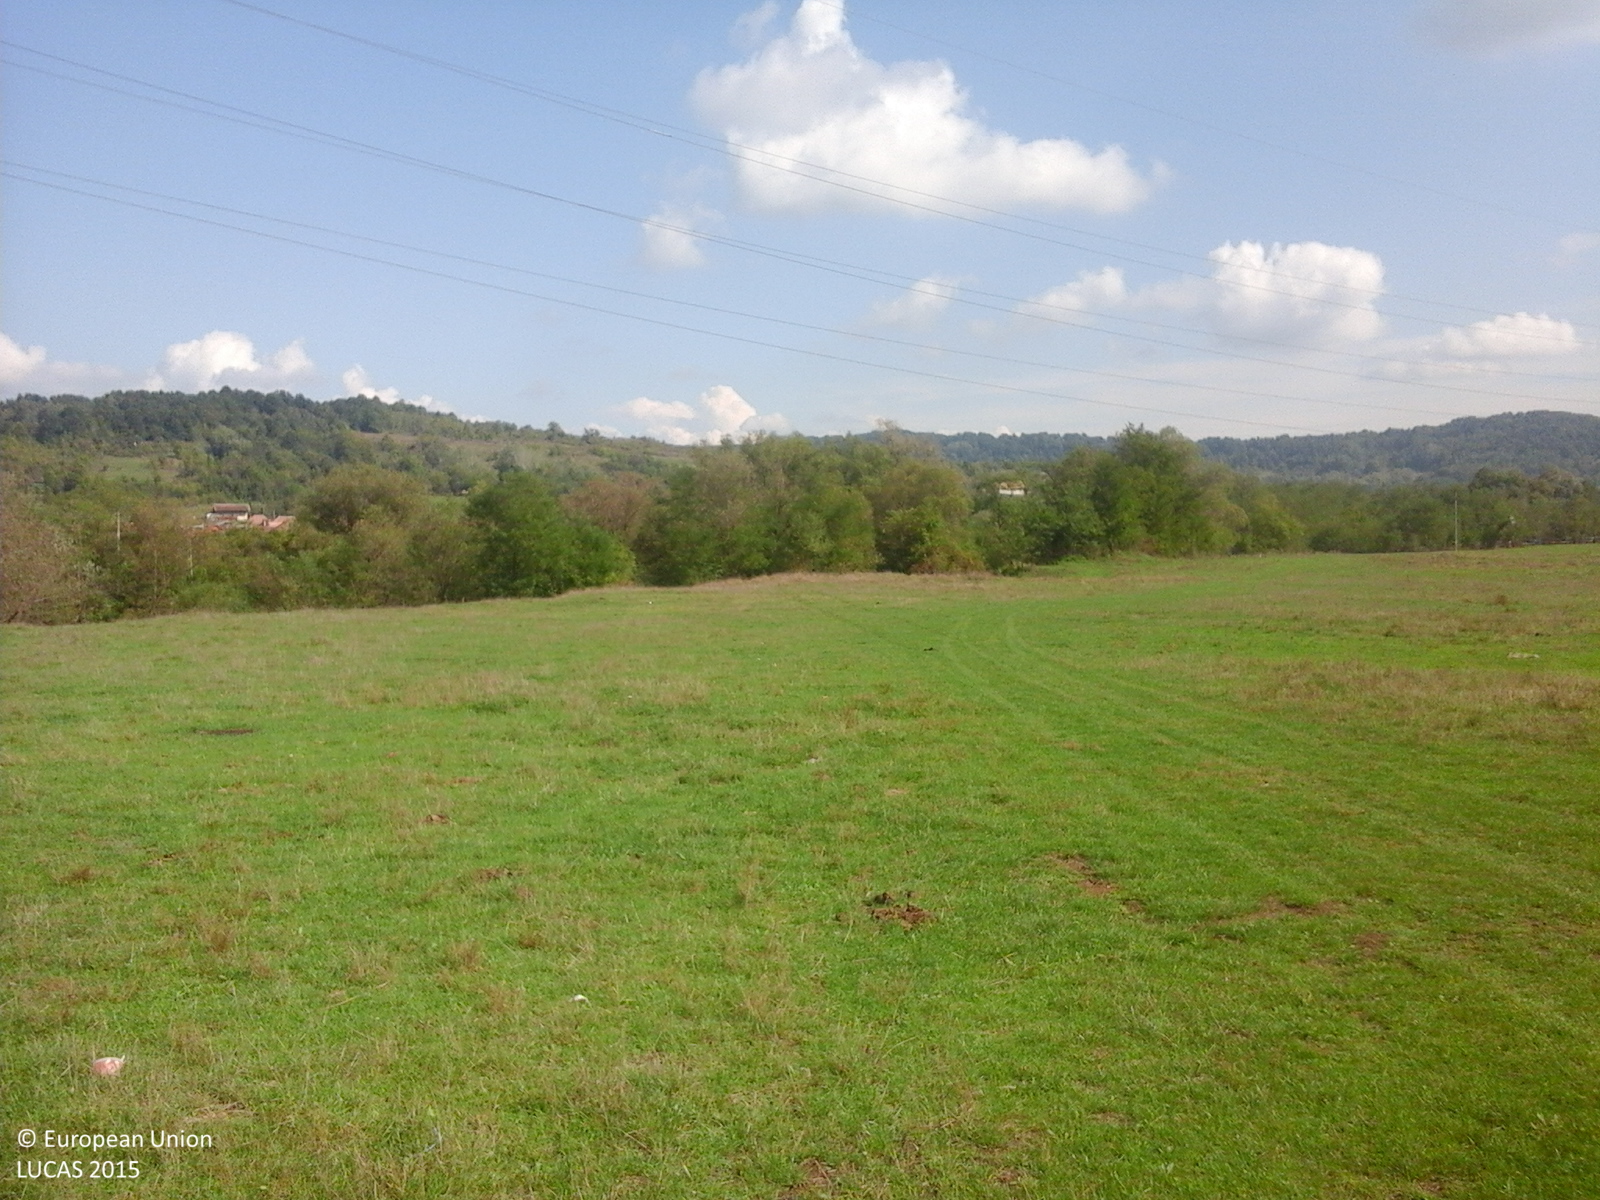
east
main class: Grassland
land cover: Grassland without tree/shrub cover
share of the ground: > 75 %
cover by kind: herbaceous plants 100 %
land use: Agriculture (excluding fallow land and kitchen gardens)
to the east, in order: Grassland without tree/shrub cover; Electric lines; Grassland without tree/shrub cover; Broadleaved woodland; Inland fresh running water; Broadleaved woodland; Tracks; Fences; Maize; Lines of trees; Lucerne
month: September
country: RO
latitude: 45.0126
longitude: 22.9530
